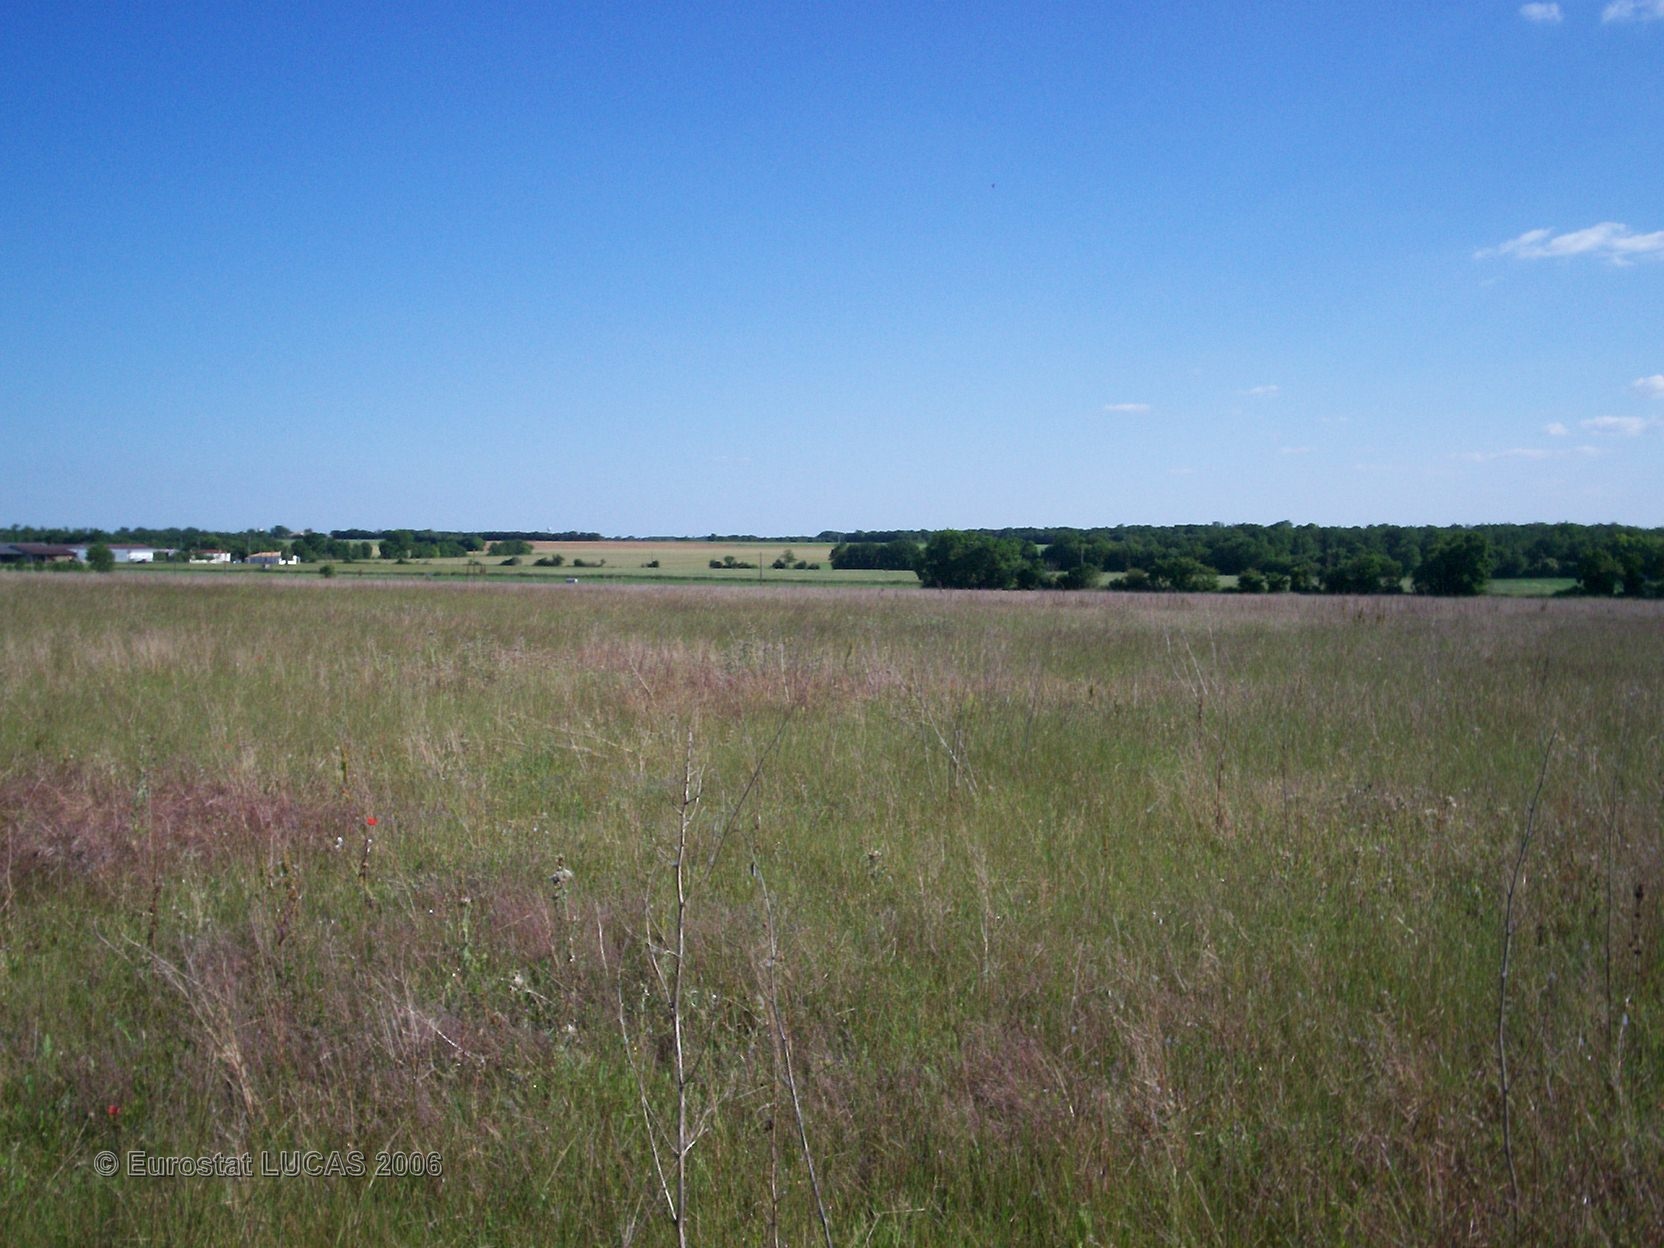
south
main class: Grassland
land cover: Grassland without tree/shrub cover
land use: Agriculture (excluding fallow land and kitchen gardens)
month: June
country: FR
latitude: 46.1518
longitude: -0.7613
